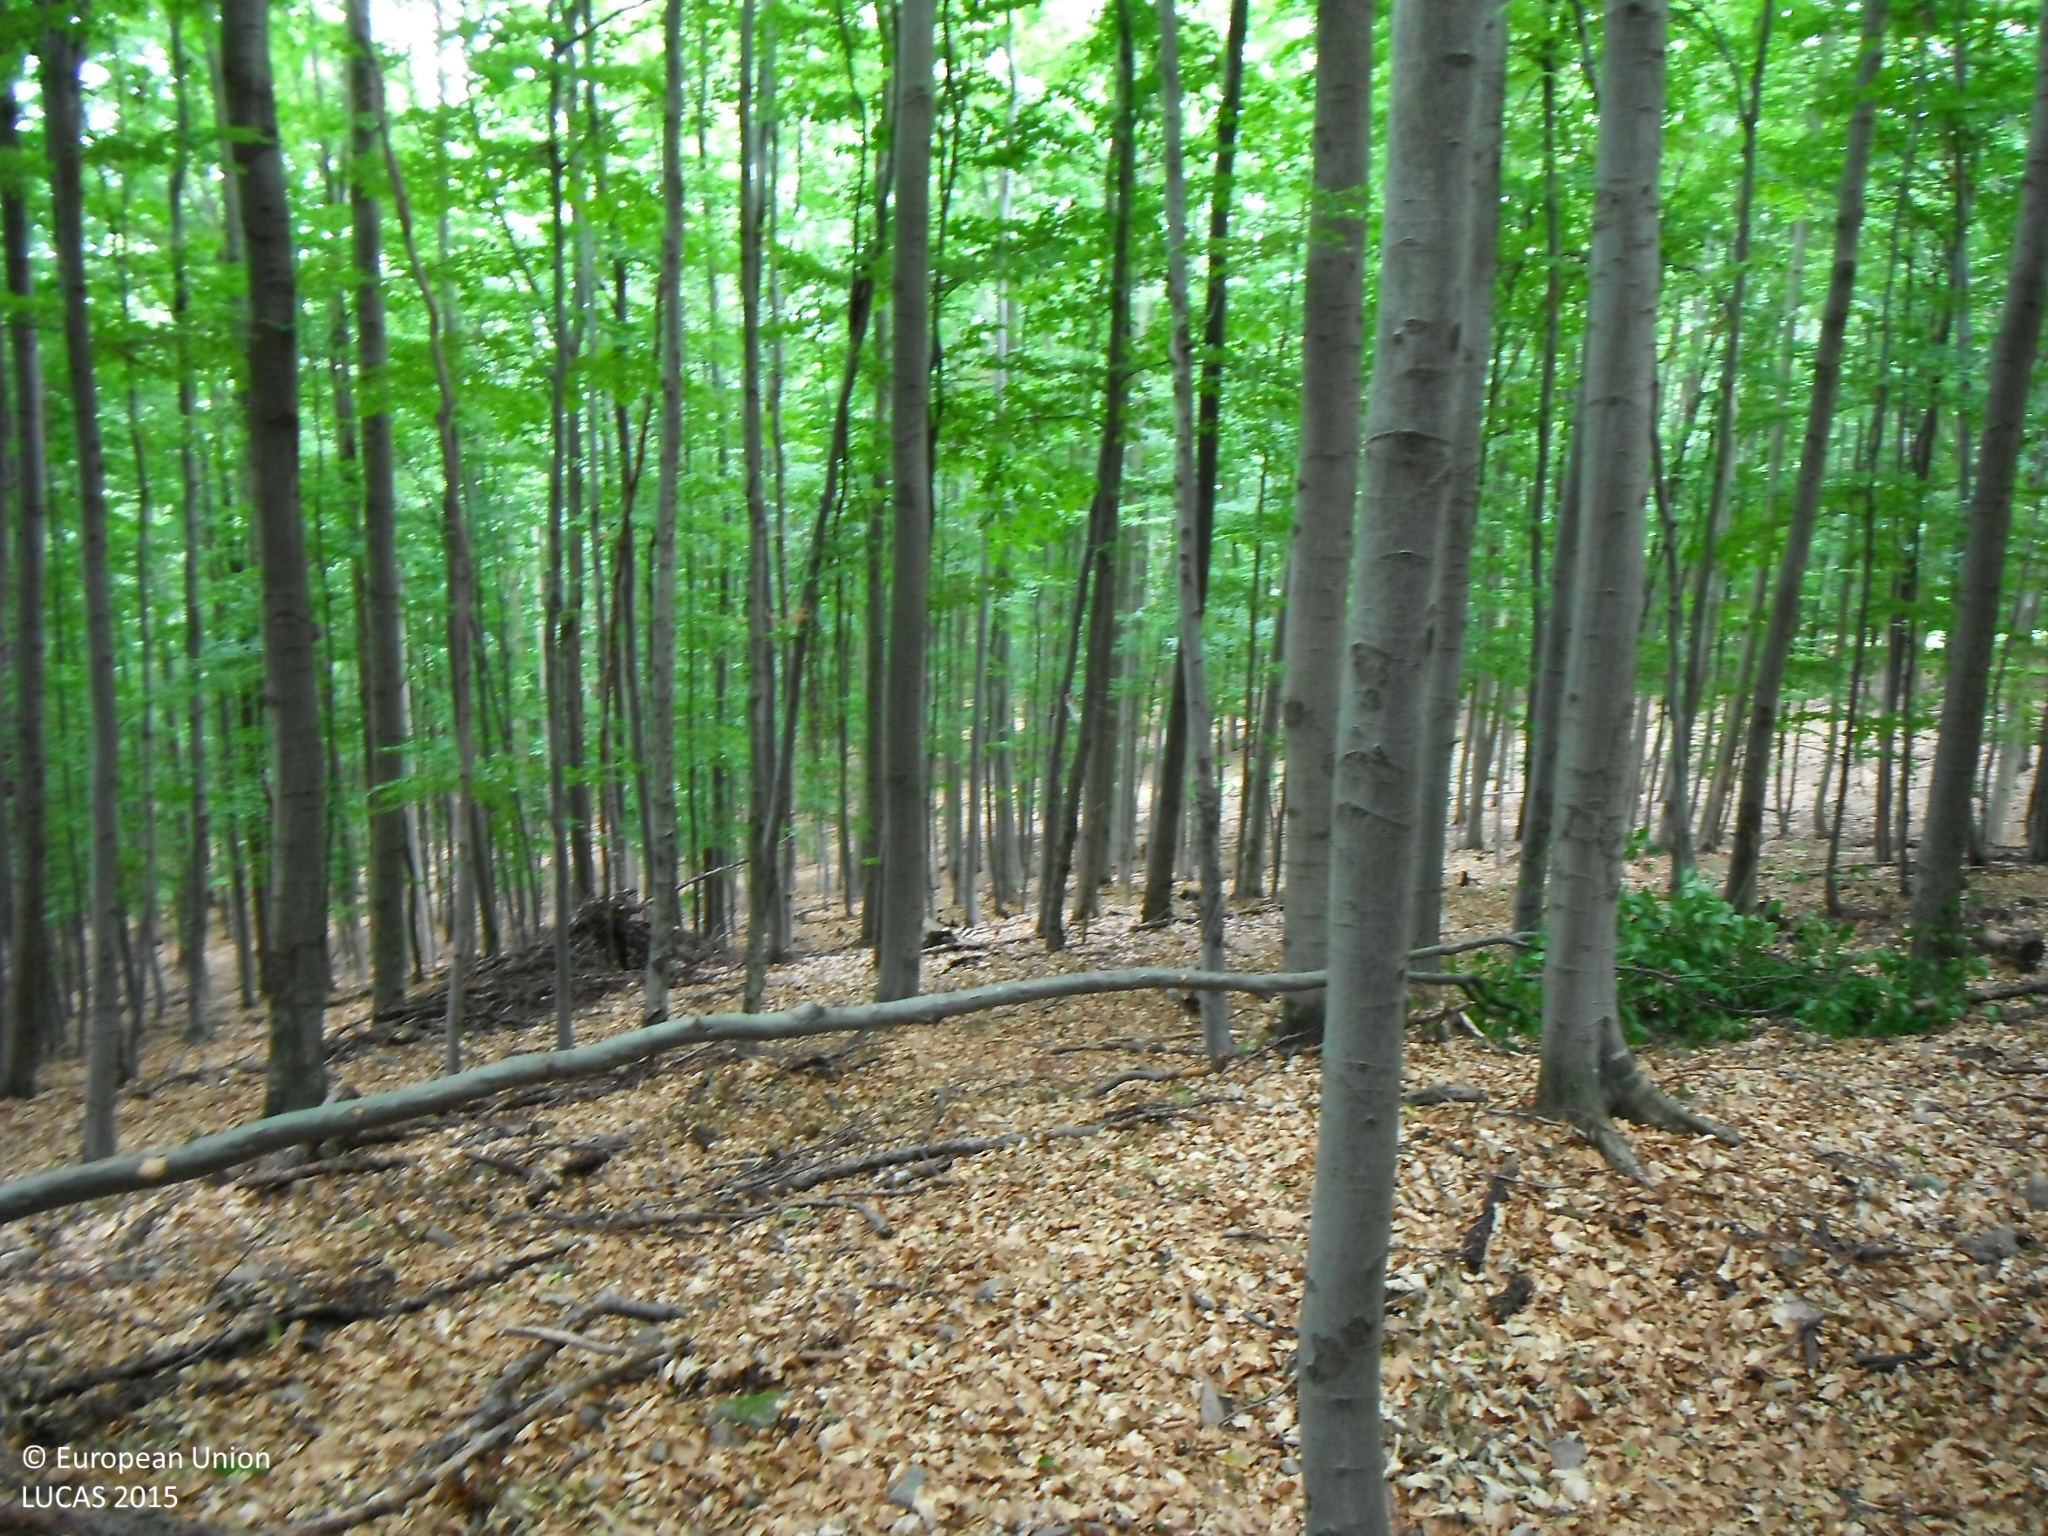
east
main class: Woodland
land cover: Broadleaved woodland
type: beech forest
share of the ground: > 75 %
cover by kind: broadleaved forest trees 100 %
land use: Forestry
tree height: > 5 m
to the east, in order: Broadleaved woodland; Tracks; Broadleaved woodland; Grassland without tree/shrub cover; Paved roads, cycling and walking lanes; Spruce dominated mixed woodland
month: July
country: SK
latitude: 48.5880
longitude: 21.4482
